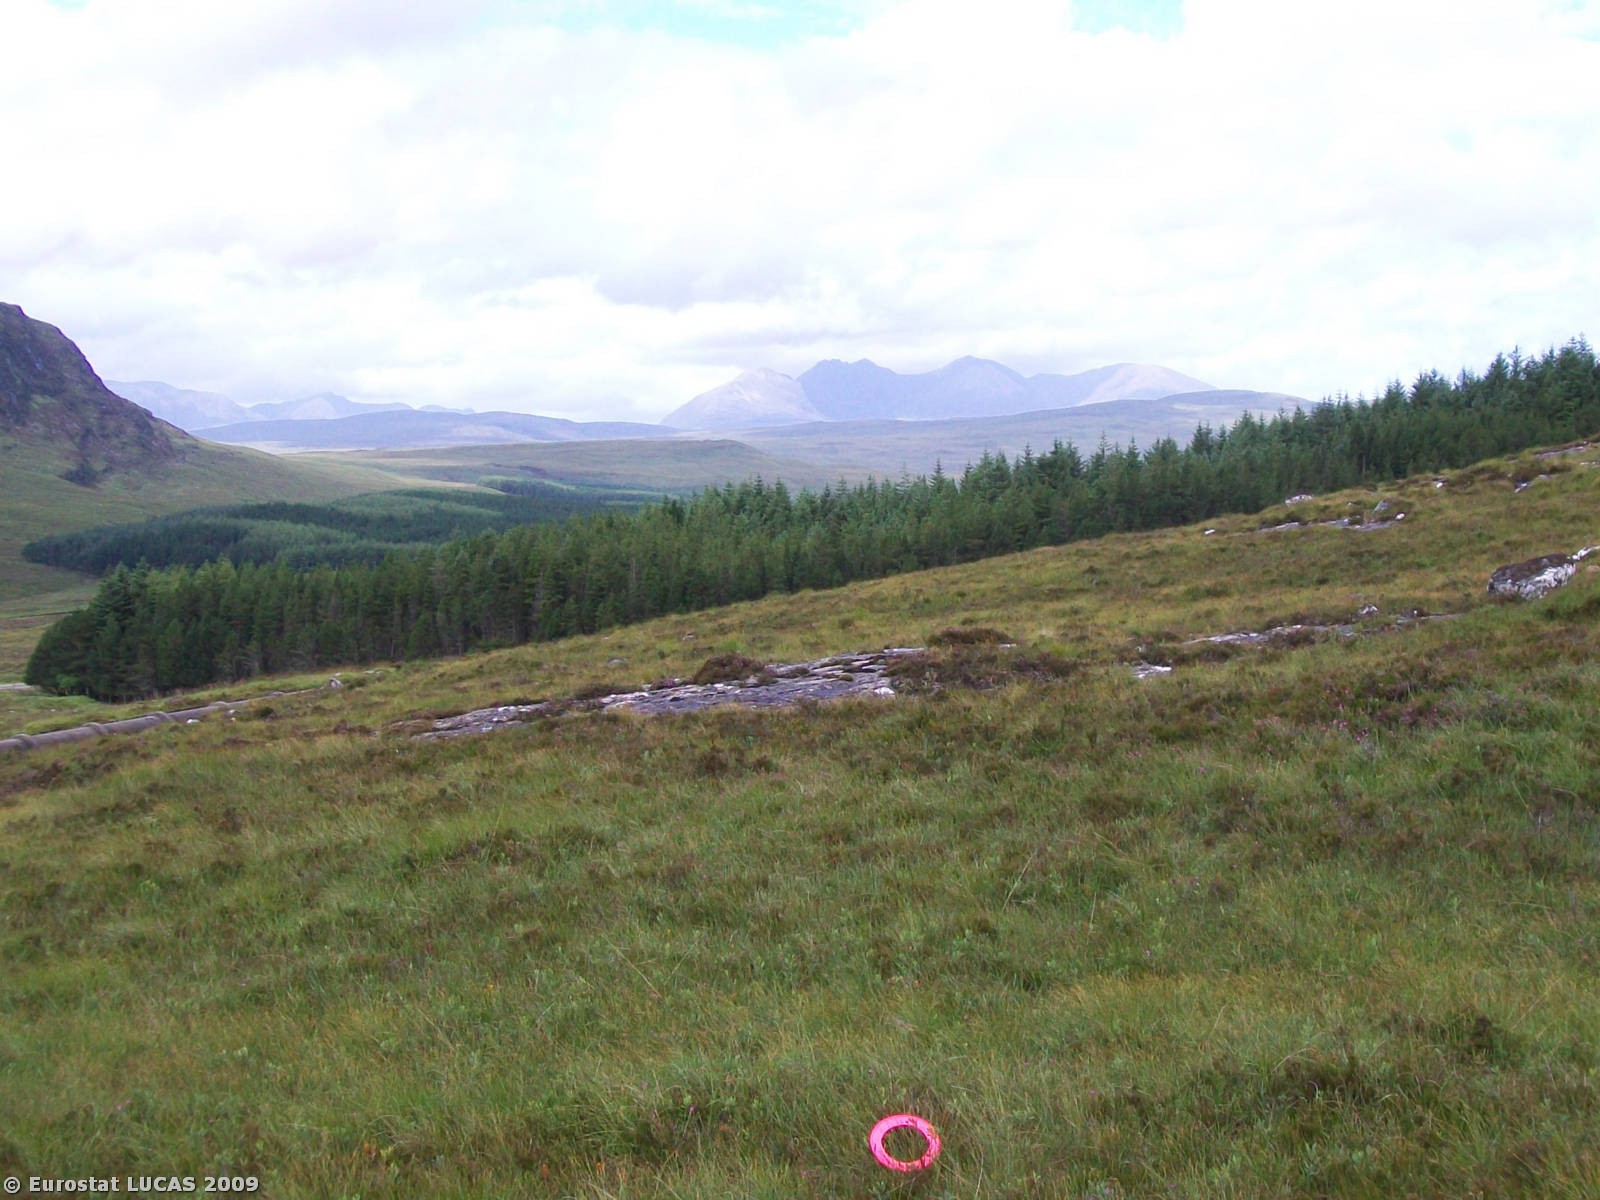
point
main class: Shrubland
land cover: Shrubland without tree cover
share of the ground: > 75 %
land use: Transport via pipelines
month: July
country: GB
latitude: 57.7413
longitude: -4.9669
